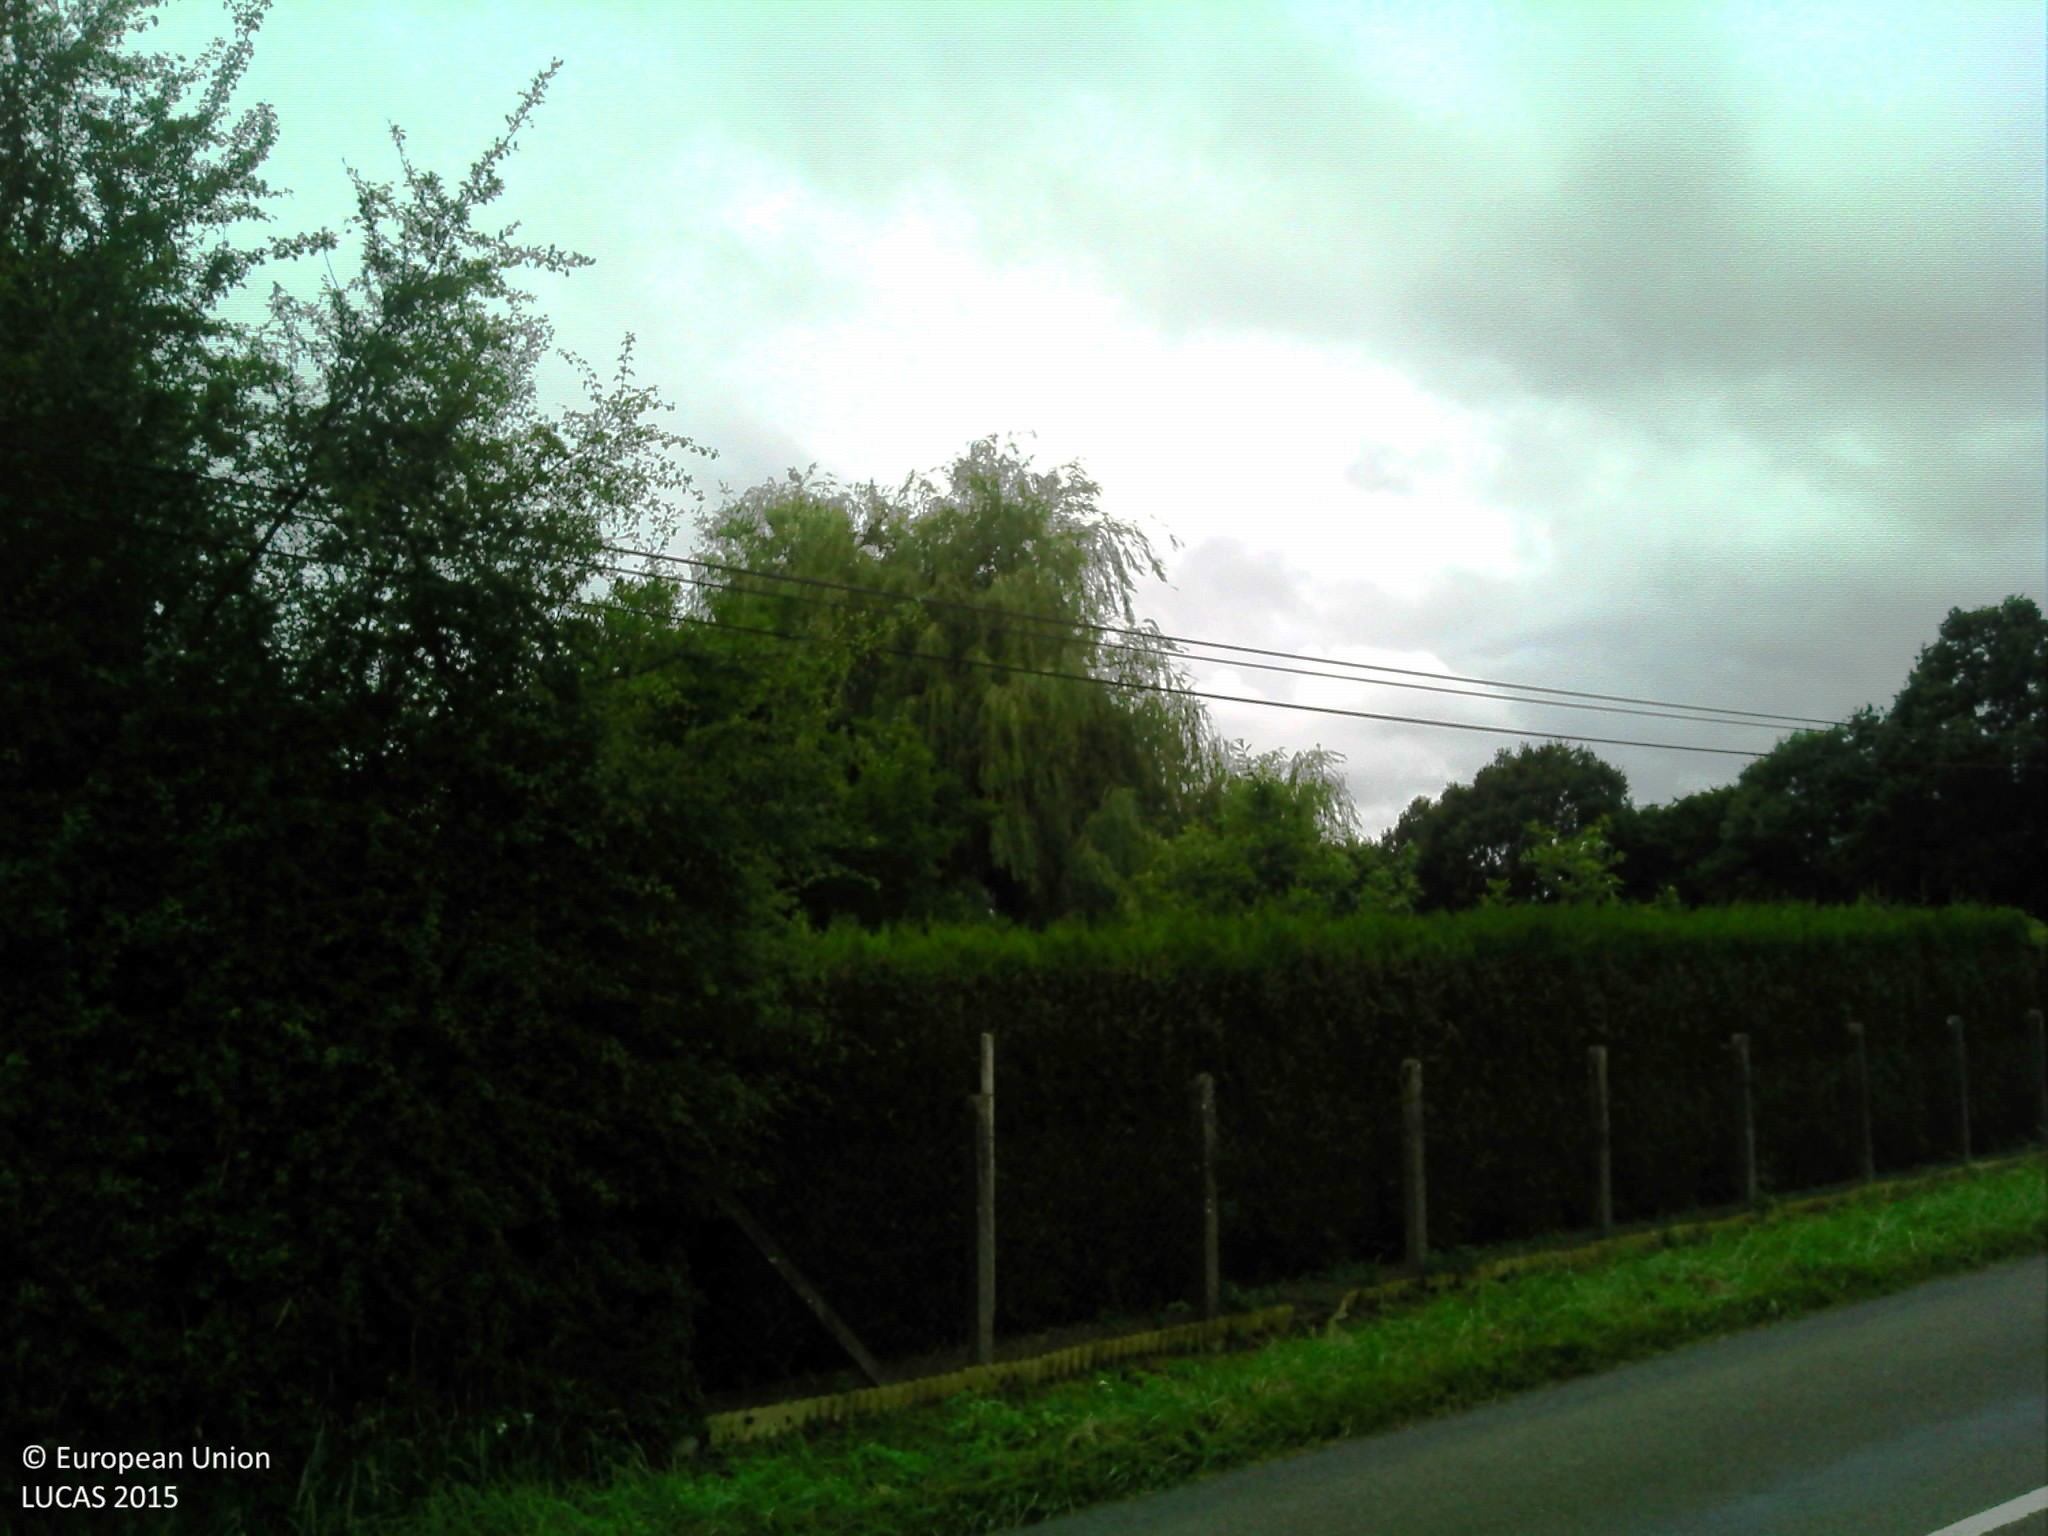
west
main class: Grassland
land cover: Grassland without tree/shrub cover
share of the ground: > 75 %
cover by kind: herbaceous plants 100 %
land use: Agriculture (excluding fallow land and kitchen gardens)
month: June
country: FR
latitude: 48.0844
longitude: 0.2955
